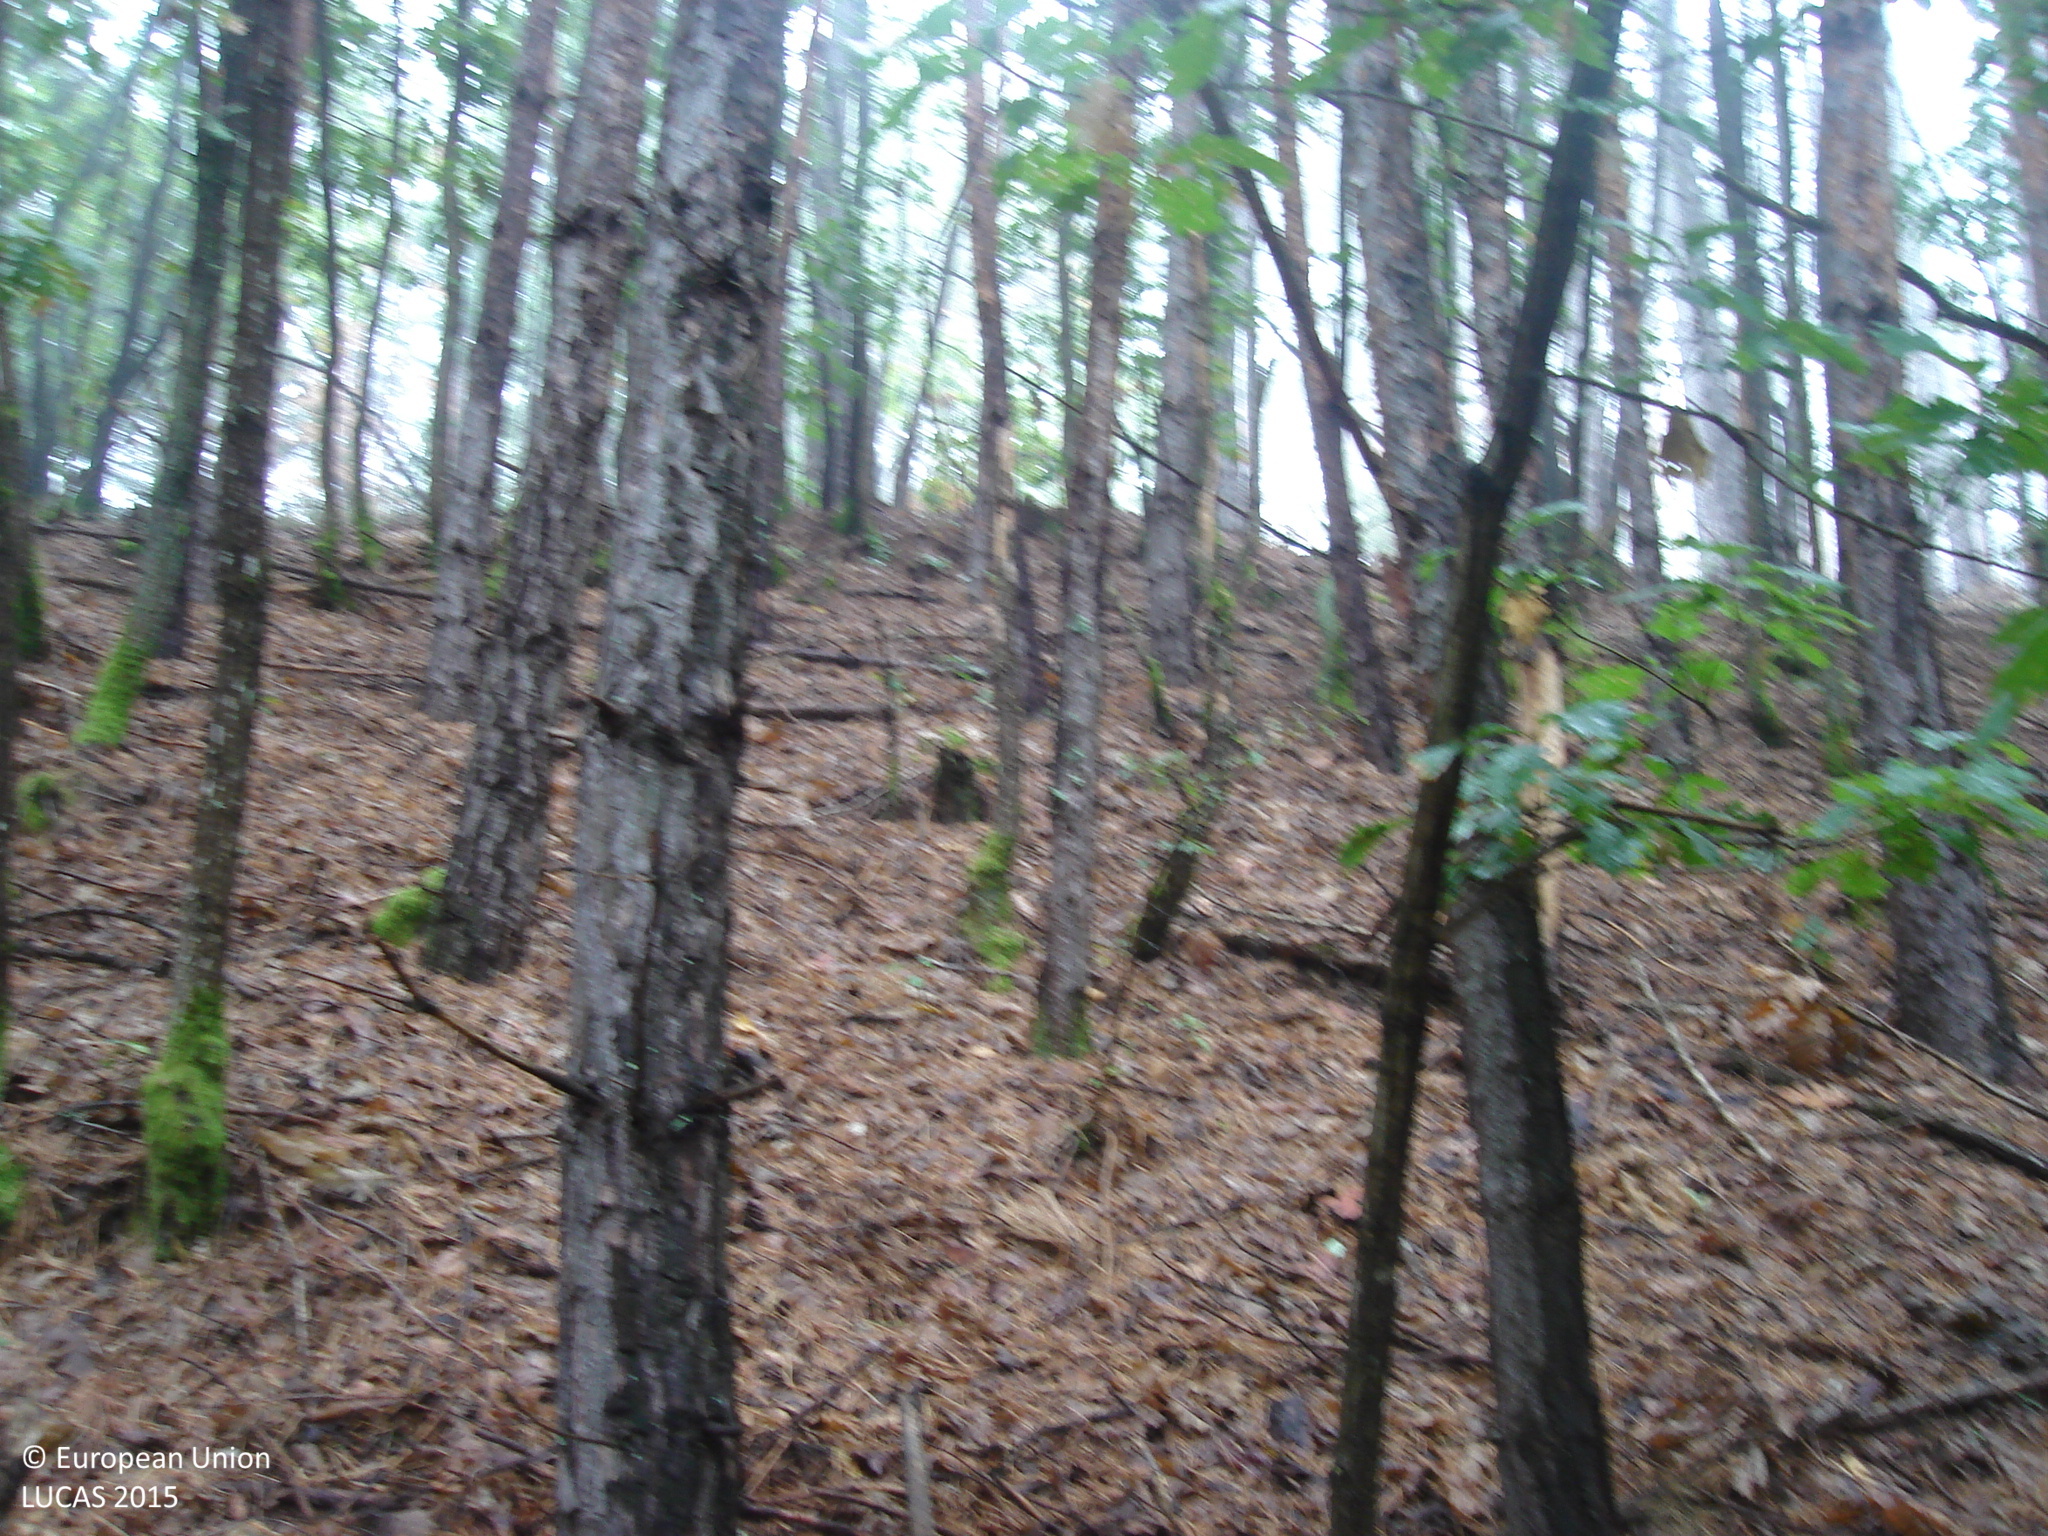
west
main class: Woodland
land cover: Pine dominated mixed woodland
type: hemiboreal forest and nemoral coniferous forest and mixed broadleaved-coniferous forest
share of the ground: > 75 %
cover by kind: coniferous forest trees 50 %, broadleaved forest trees 30 %, unconsolidated bare surface 15 %, herbaceous plants 5 %
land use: Forestry
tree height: > 5 m
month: September
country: BG
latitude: 42.9923
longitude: 23.1959
